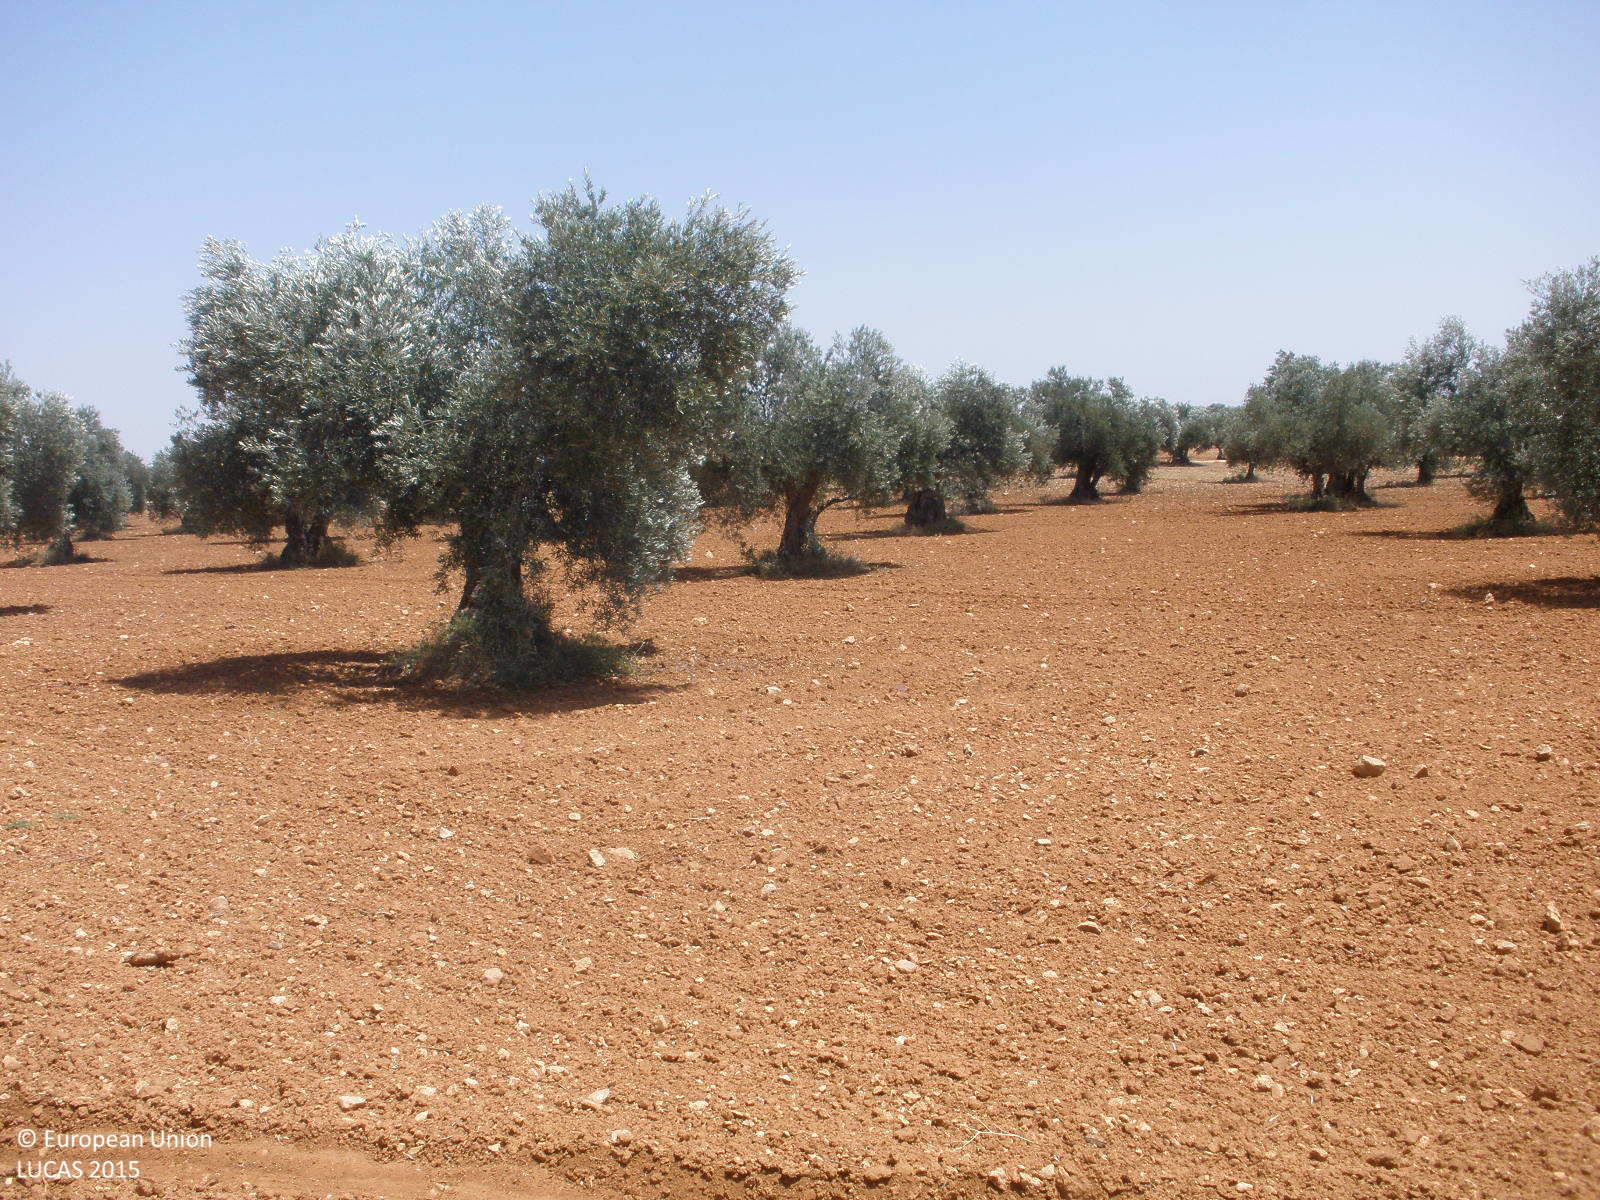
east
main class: Cropland
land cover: Olive groves
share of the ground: 25 - 50 %
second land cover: Other bare soil
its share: > 75 %
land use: Agriculture (excluding fallow land and kitchen gardens)
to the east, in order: Olive groves; Other bare soil; Tracks; Olive groves
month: July
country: ES
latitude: 40.2285
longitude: -3.4889
